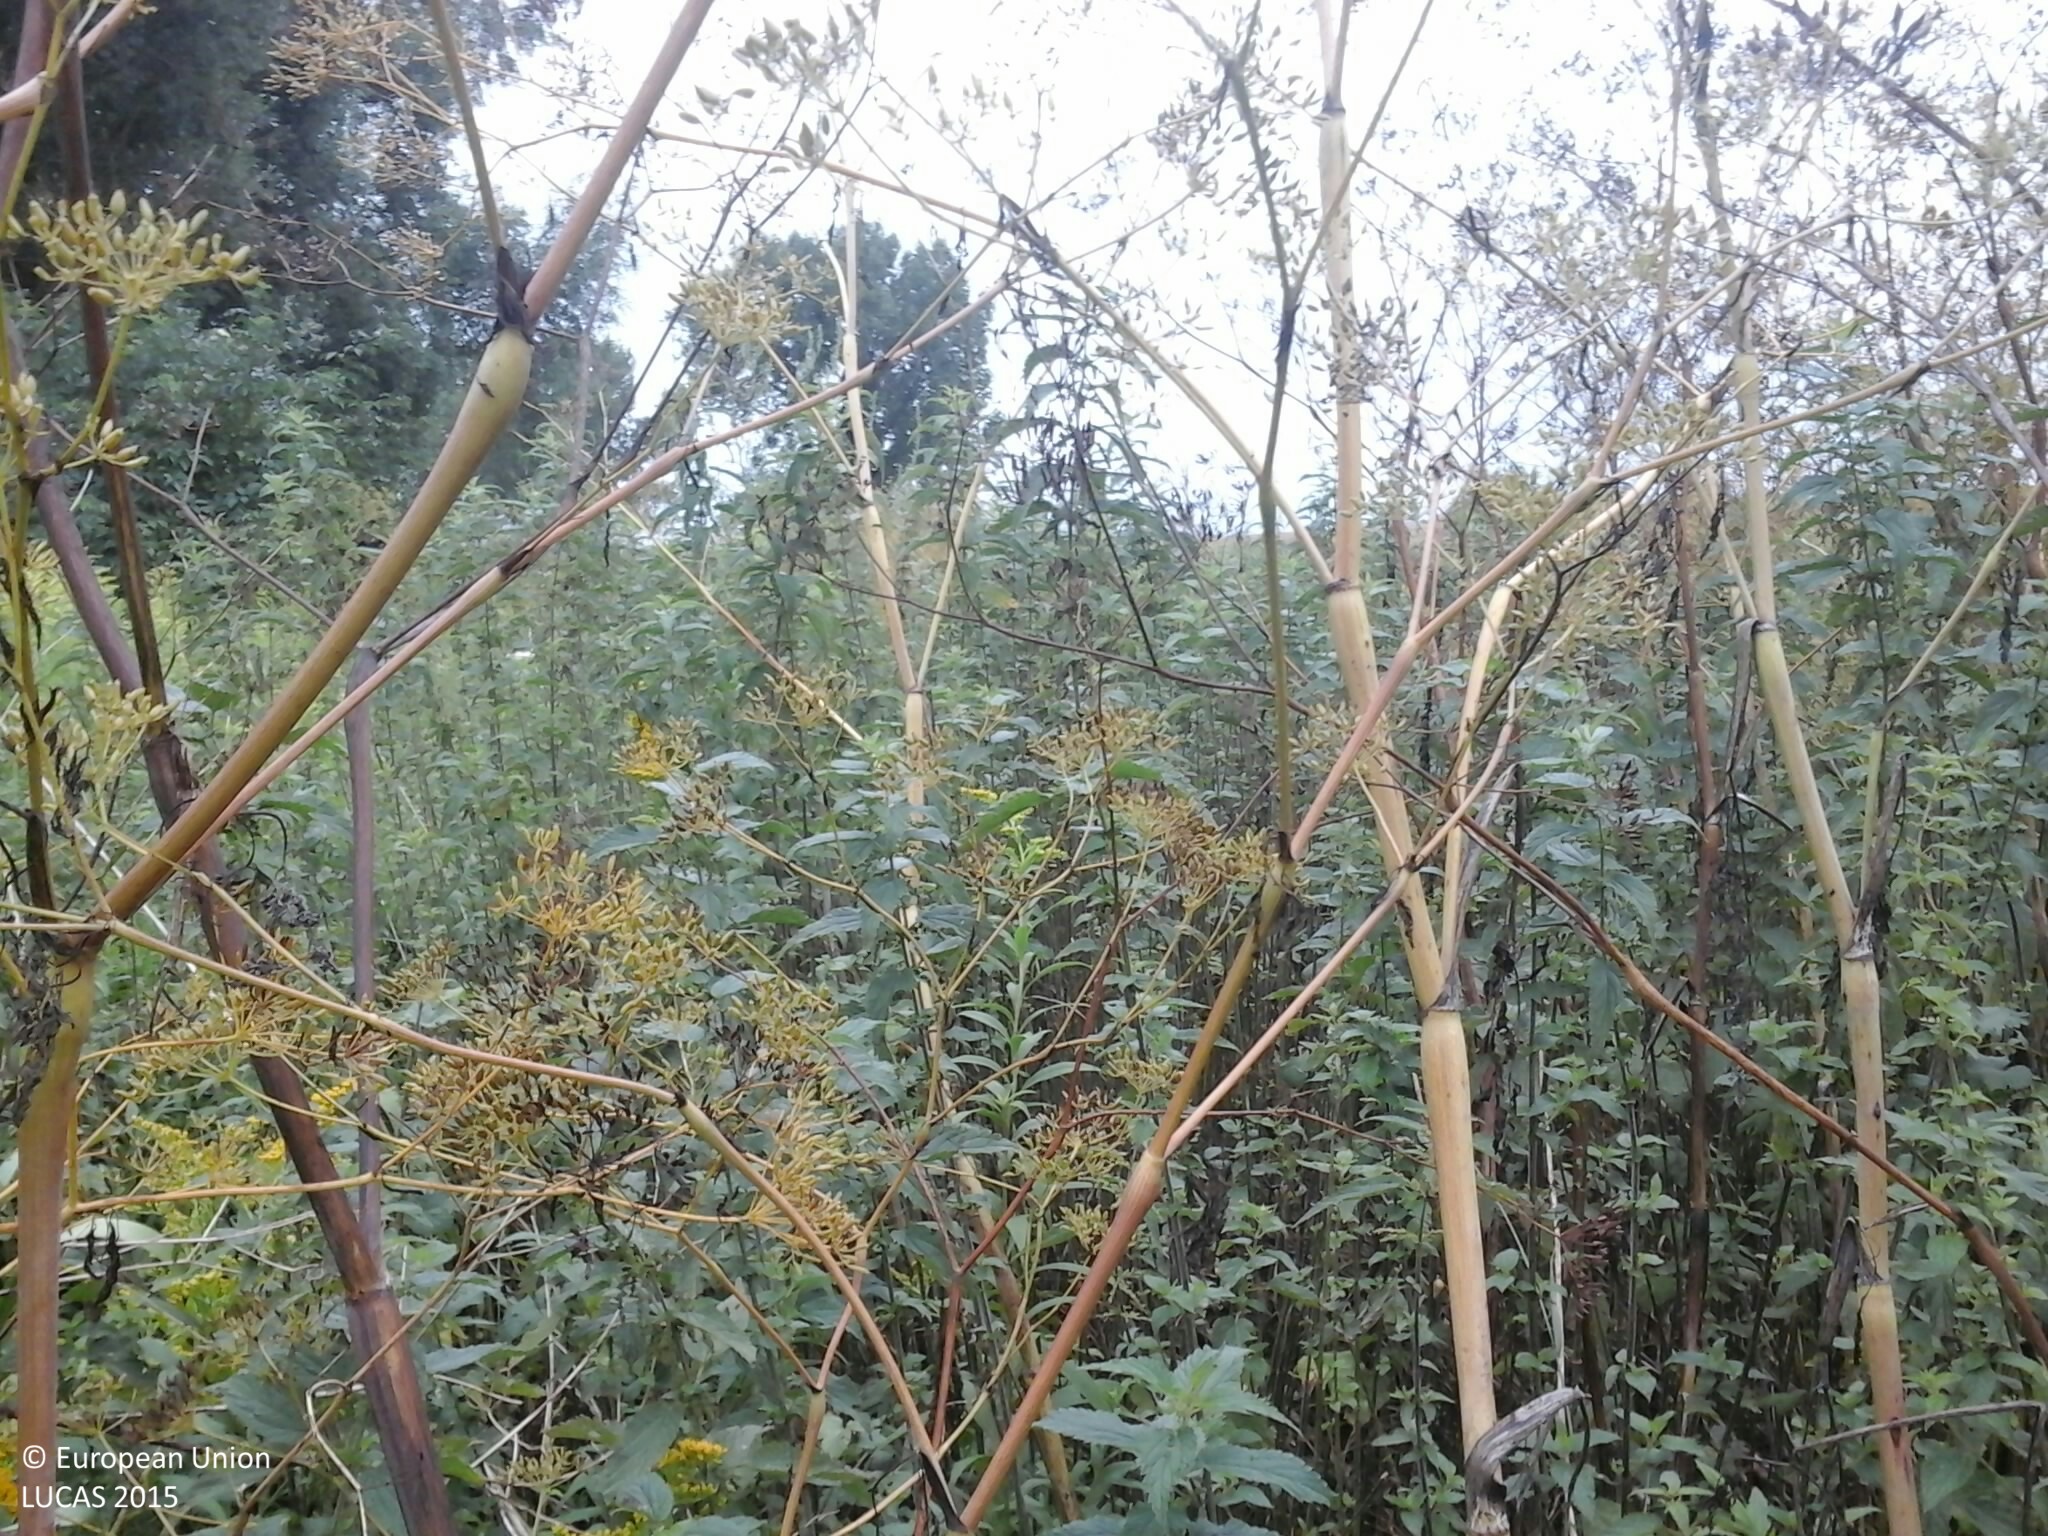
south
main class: Grassland
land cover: Spontaneously vegetated surfaces
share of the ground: > 75 %
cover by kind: herbaceous plants 100 %
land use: Semi-natural and natural areas not in use
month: July
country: HU
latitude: 46.5607
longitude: 17.7156
